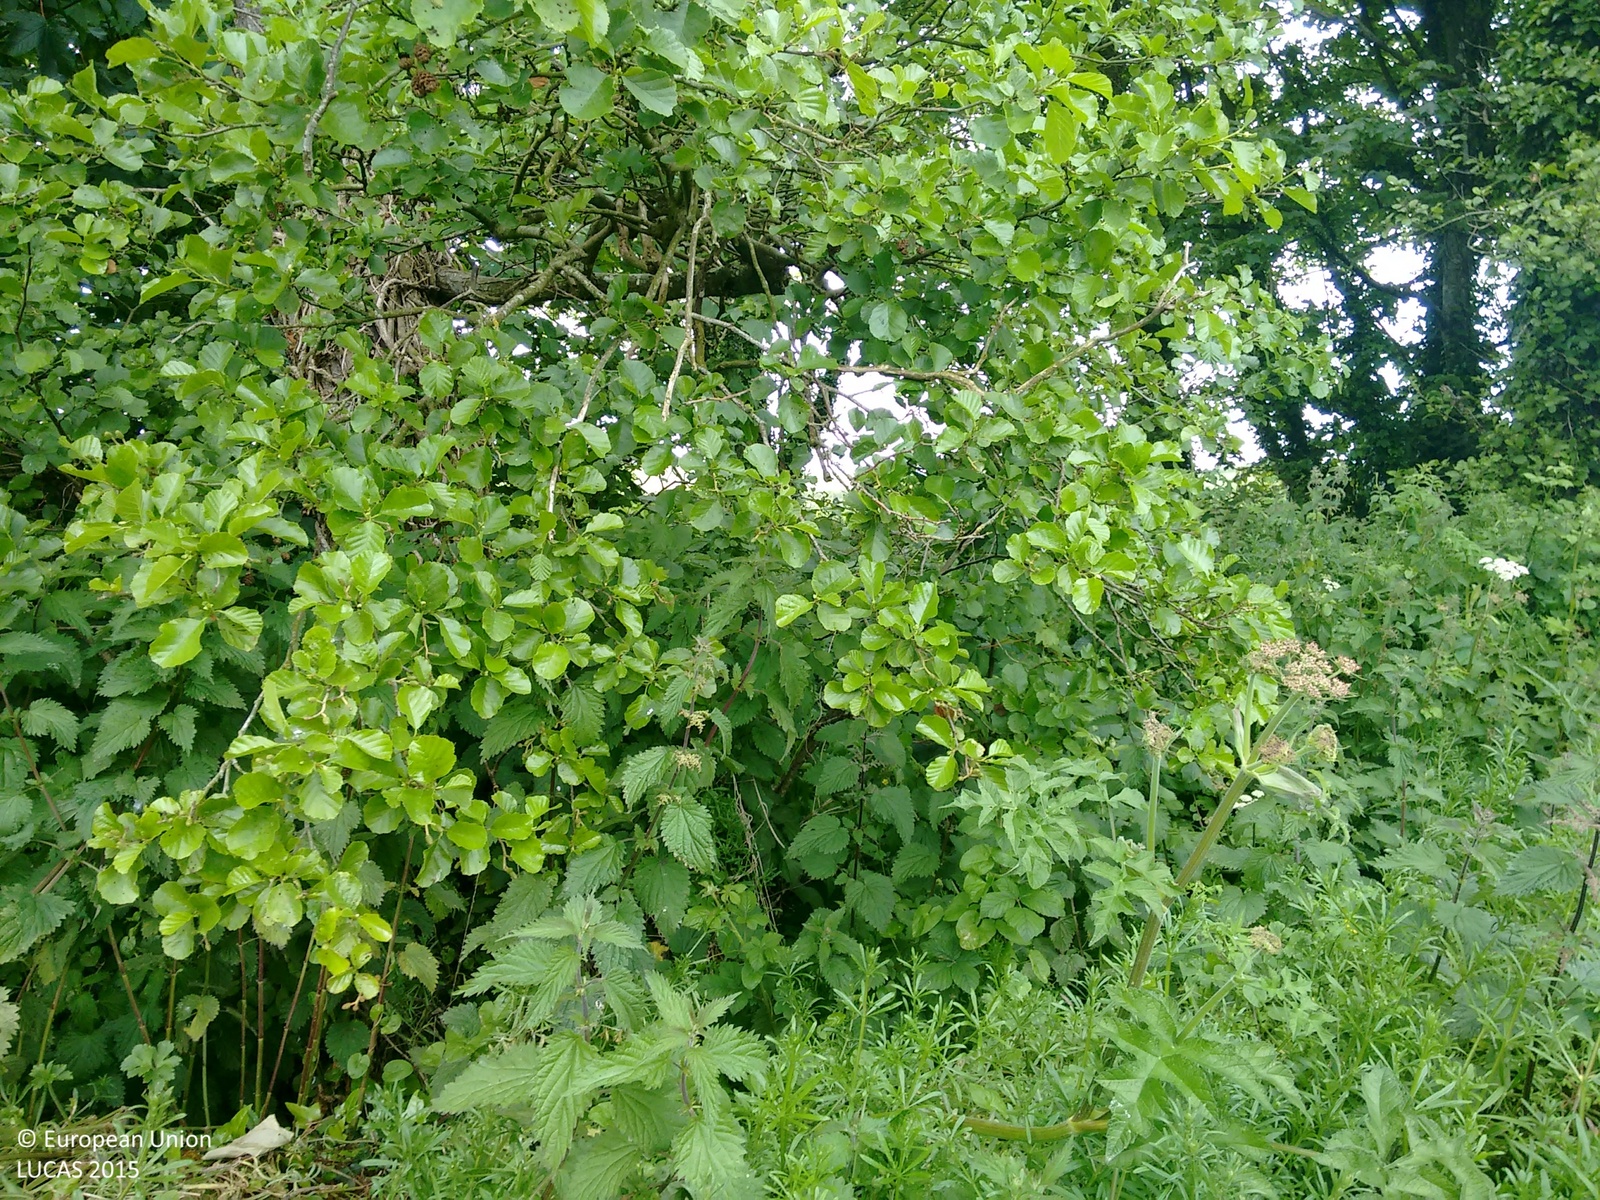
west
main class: Woodland
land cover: Broadleaved woodland
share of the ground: > 75 %
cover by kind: broadleaved forest trees 100 %
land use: Semi-natural and natural areas not in use
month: June
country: IE
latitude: 51.6281
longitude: -8.7071
